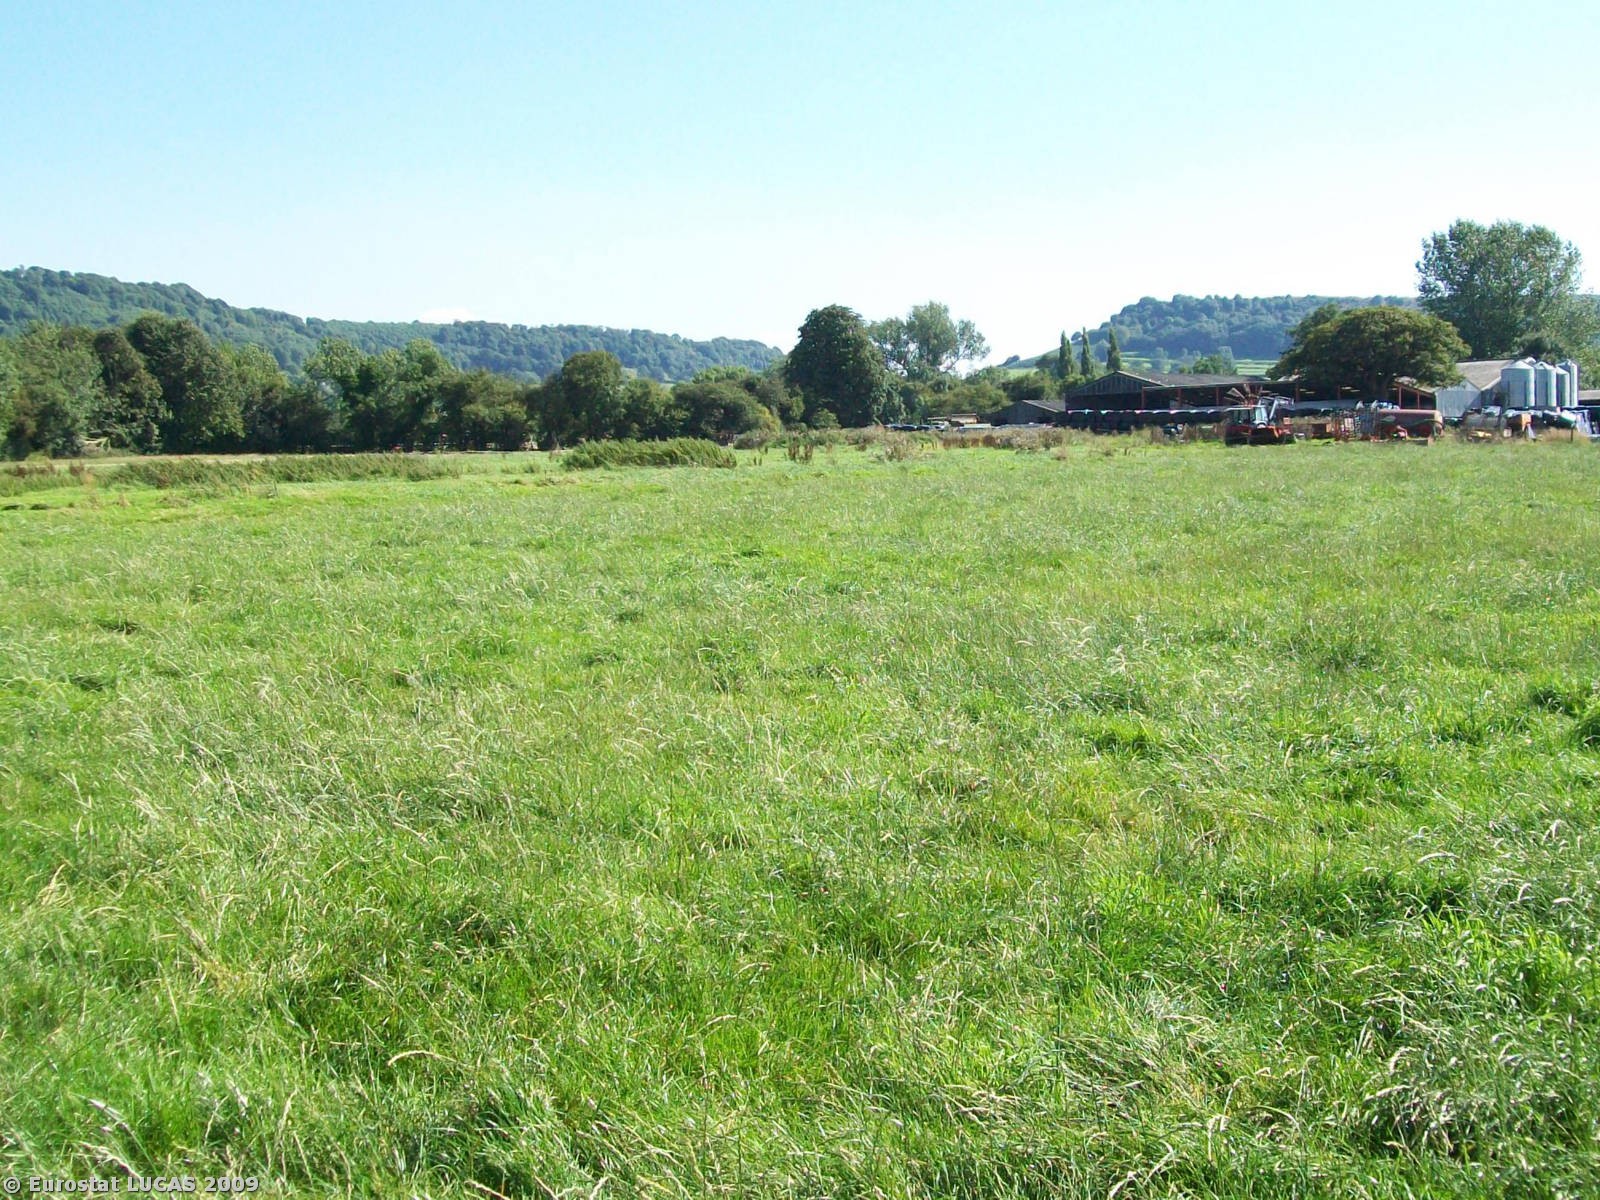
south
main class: Grassland
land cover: Grassland without tree/shrub cover
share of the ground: > 75 %
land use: Agriculture (excluding fallow land and kitchen gardens)
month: August
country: GB
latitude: 51.7142
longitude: -2.3227
